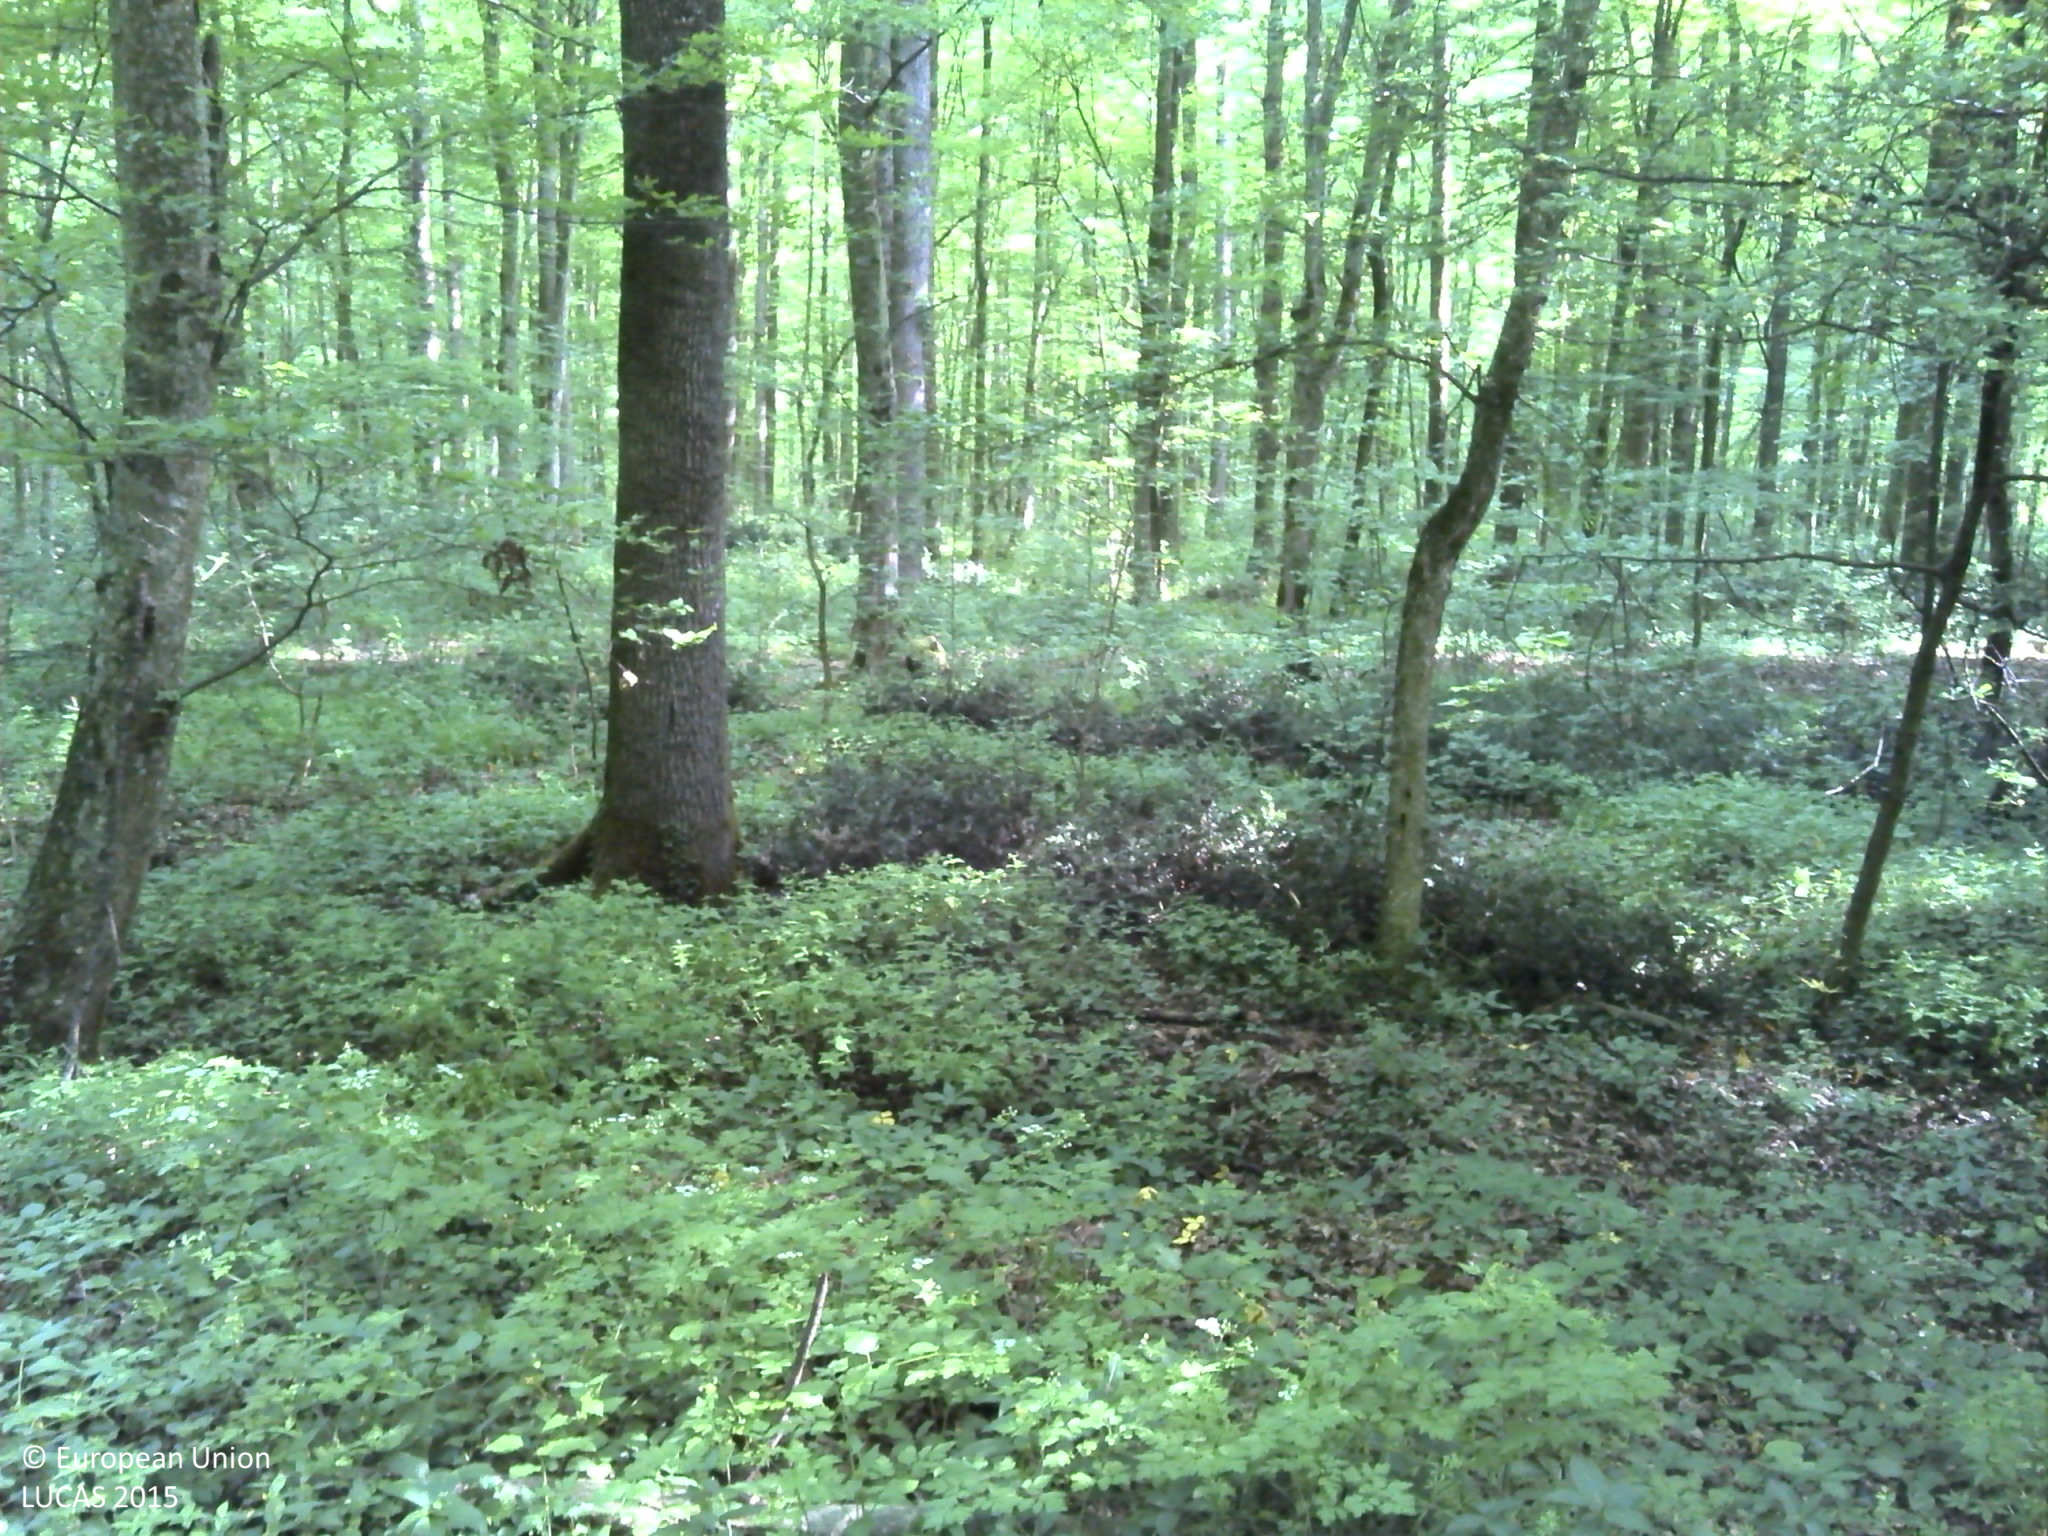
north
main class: Woodland
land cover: Broadleaved woodland
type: acidophilous oak and oak-birch forest
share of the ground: > 75 %
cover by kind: broadleaved forest trees 100 %
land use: Forestry
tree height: > 5 m
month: May
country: HR
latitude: 45.6156
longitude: 18.2512
